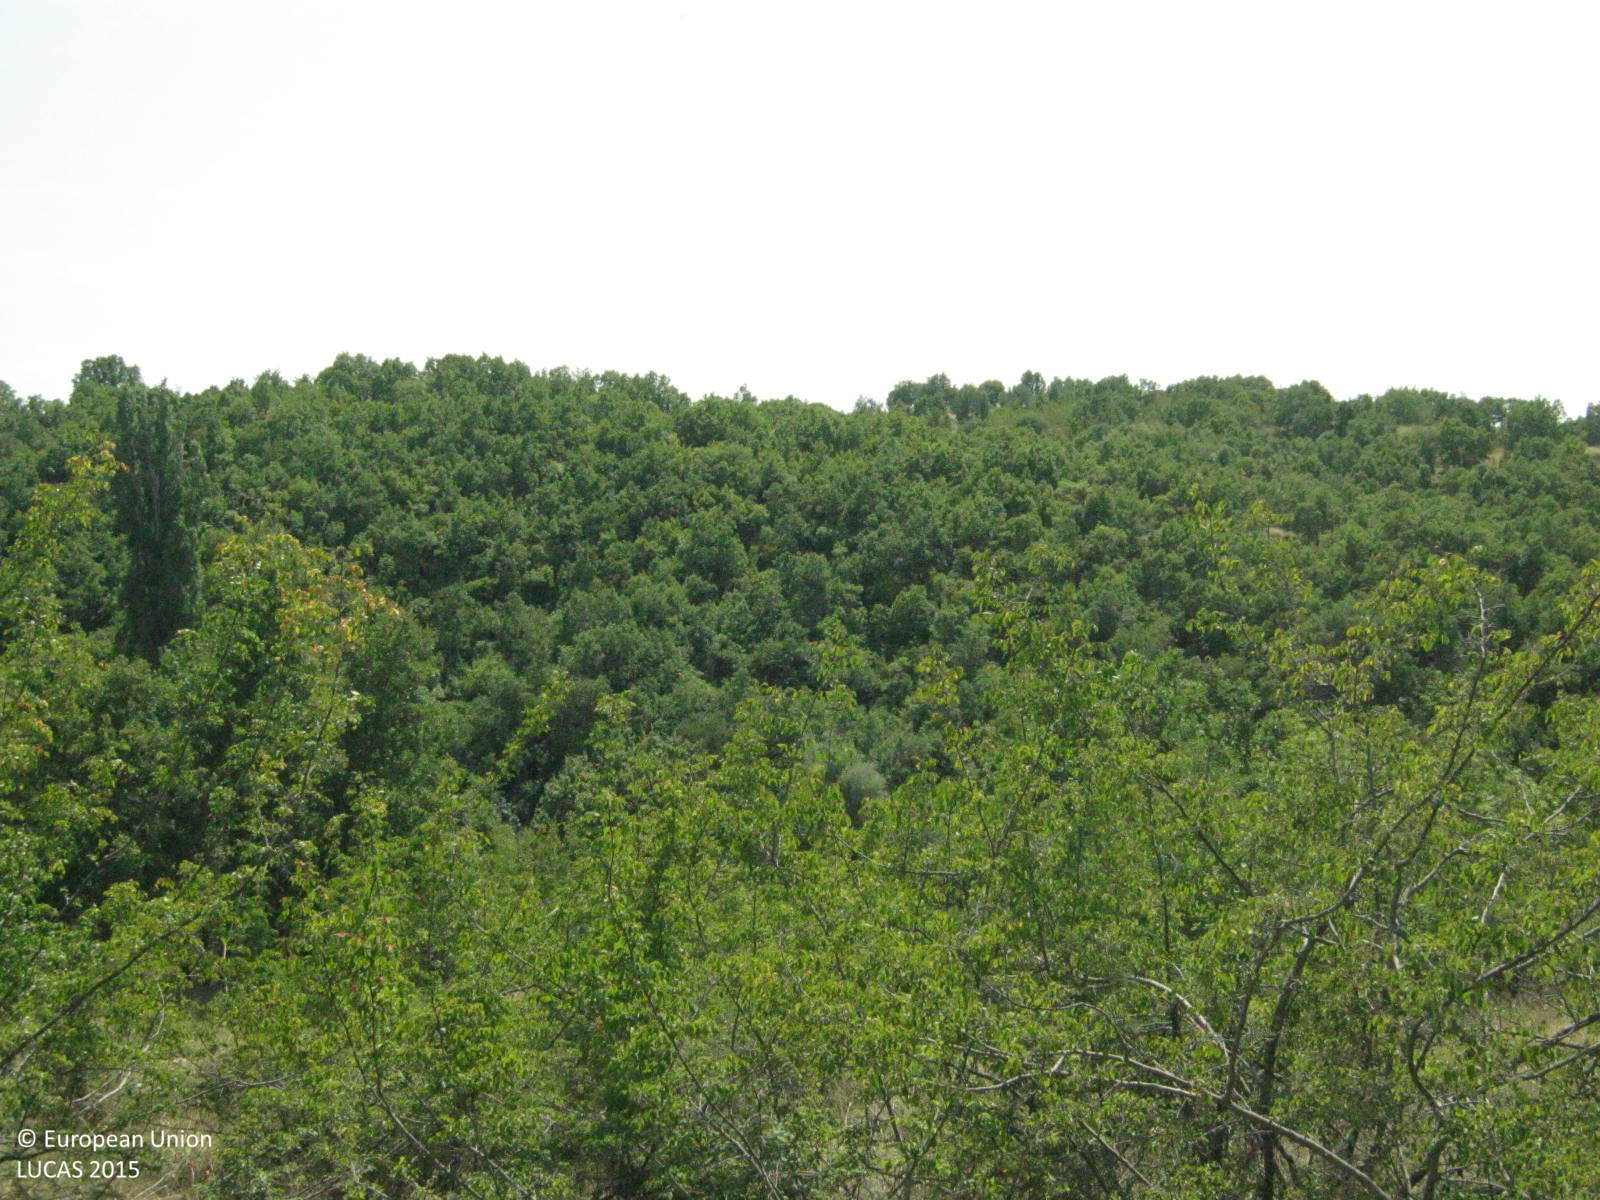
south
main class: Woodland
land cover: Broadleaved woodland
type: thermophilous deciduous forest
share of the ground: 10 - 25 %
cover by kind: herbaceous plants 70 %, broadleaved forest trees 20 %, shrubs 10 %
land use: Semi-natural and natural areas not in use
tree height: > 5 m
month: August
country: GR
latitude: 40.9360
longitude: 22.9927
